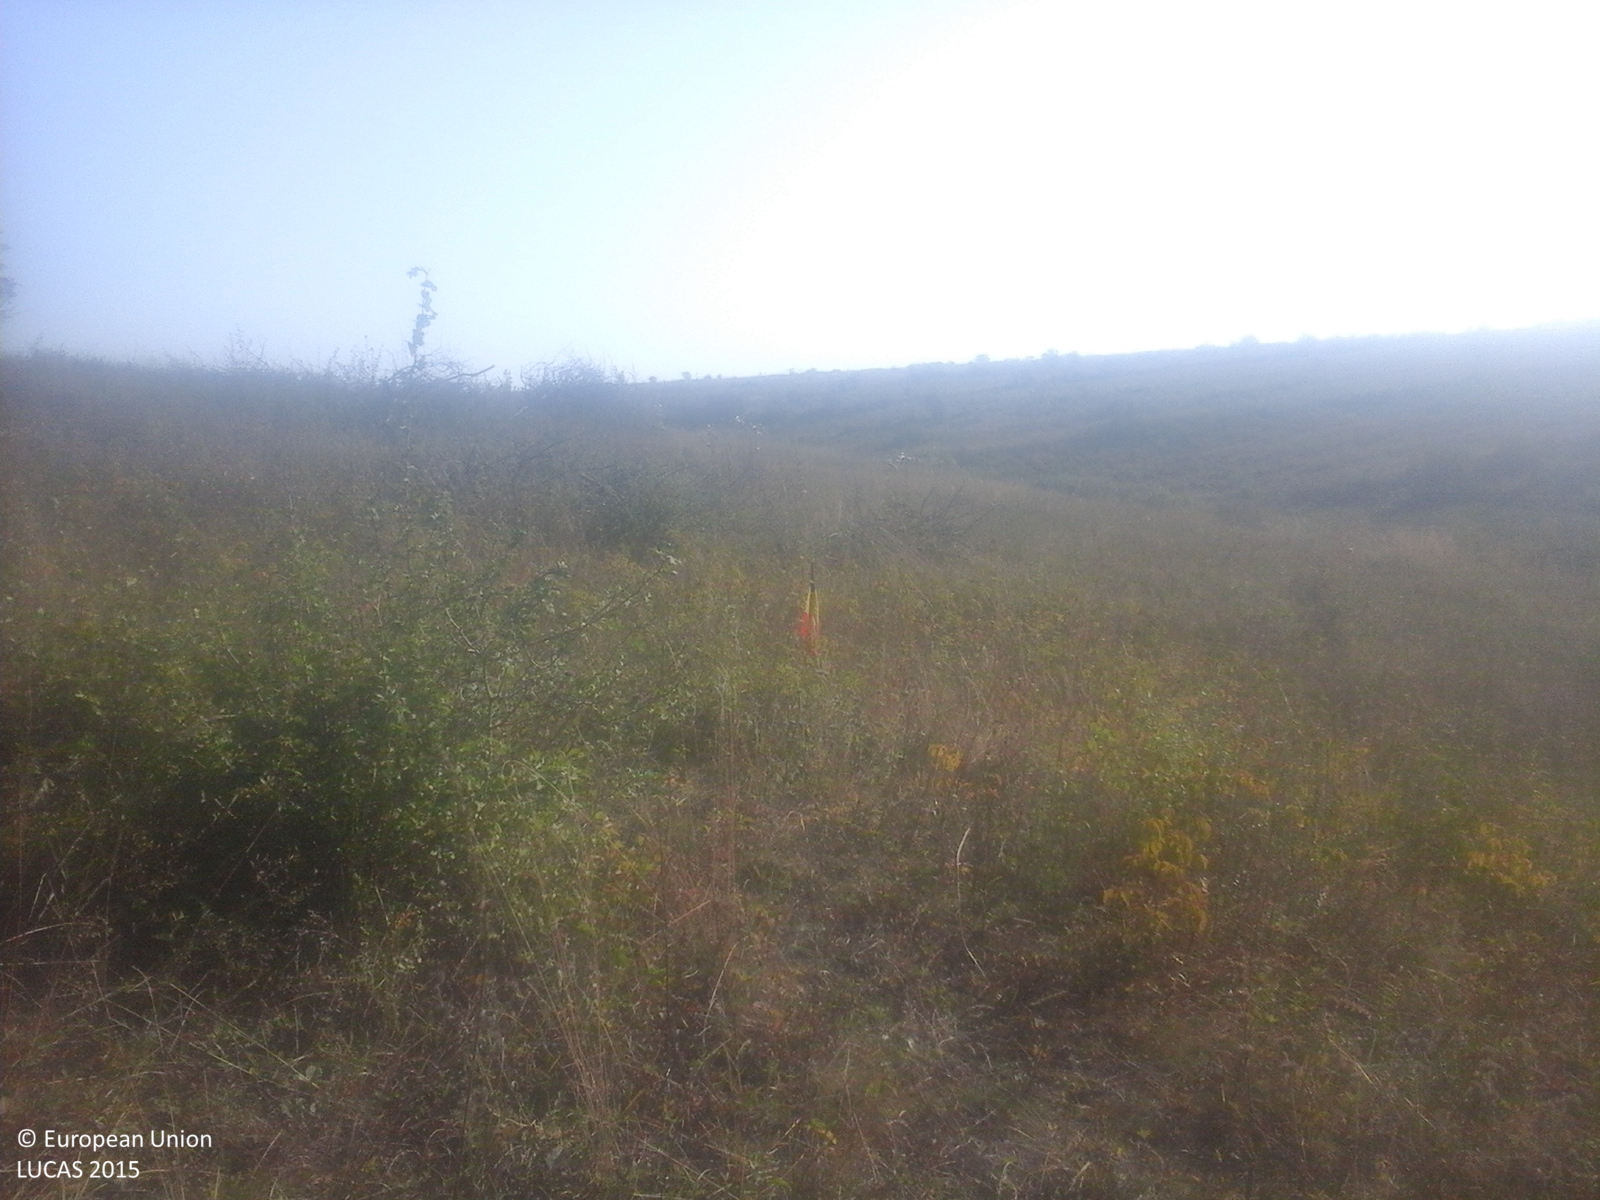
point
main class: Grassland
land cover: Grassland with sparse tree/shrub cover
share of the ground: > 75 %
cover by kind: herbaceous plants 85 %, shrubs 10 %, broadleaved forest trees 5 %
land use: Agriculture (excluding fallow land and kitchen gardens)
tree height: < 5 m
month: September
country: RO
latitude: 47.0349
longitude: 24.2584
